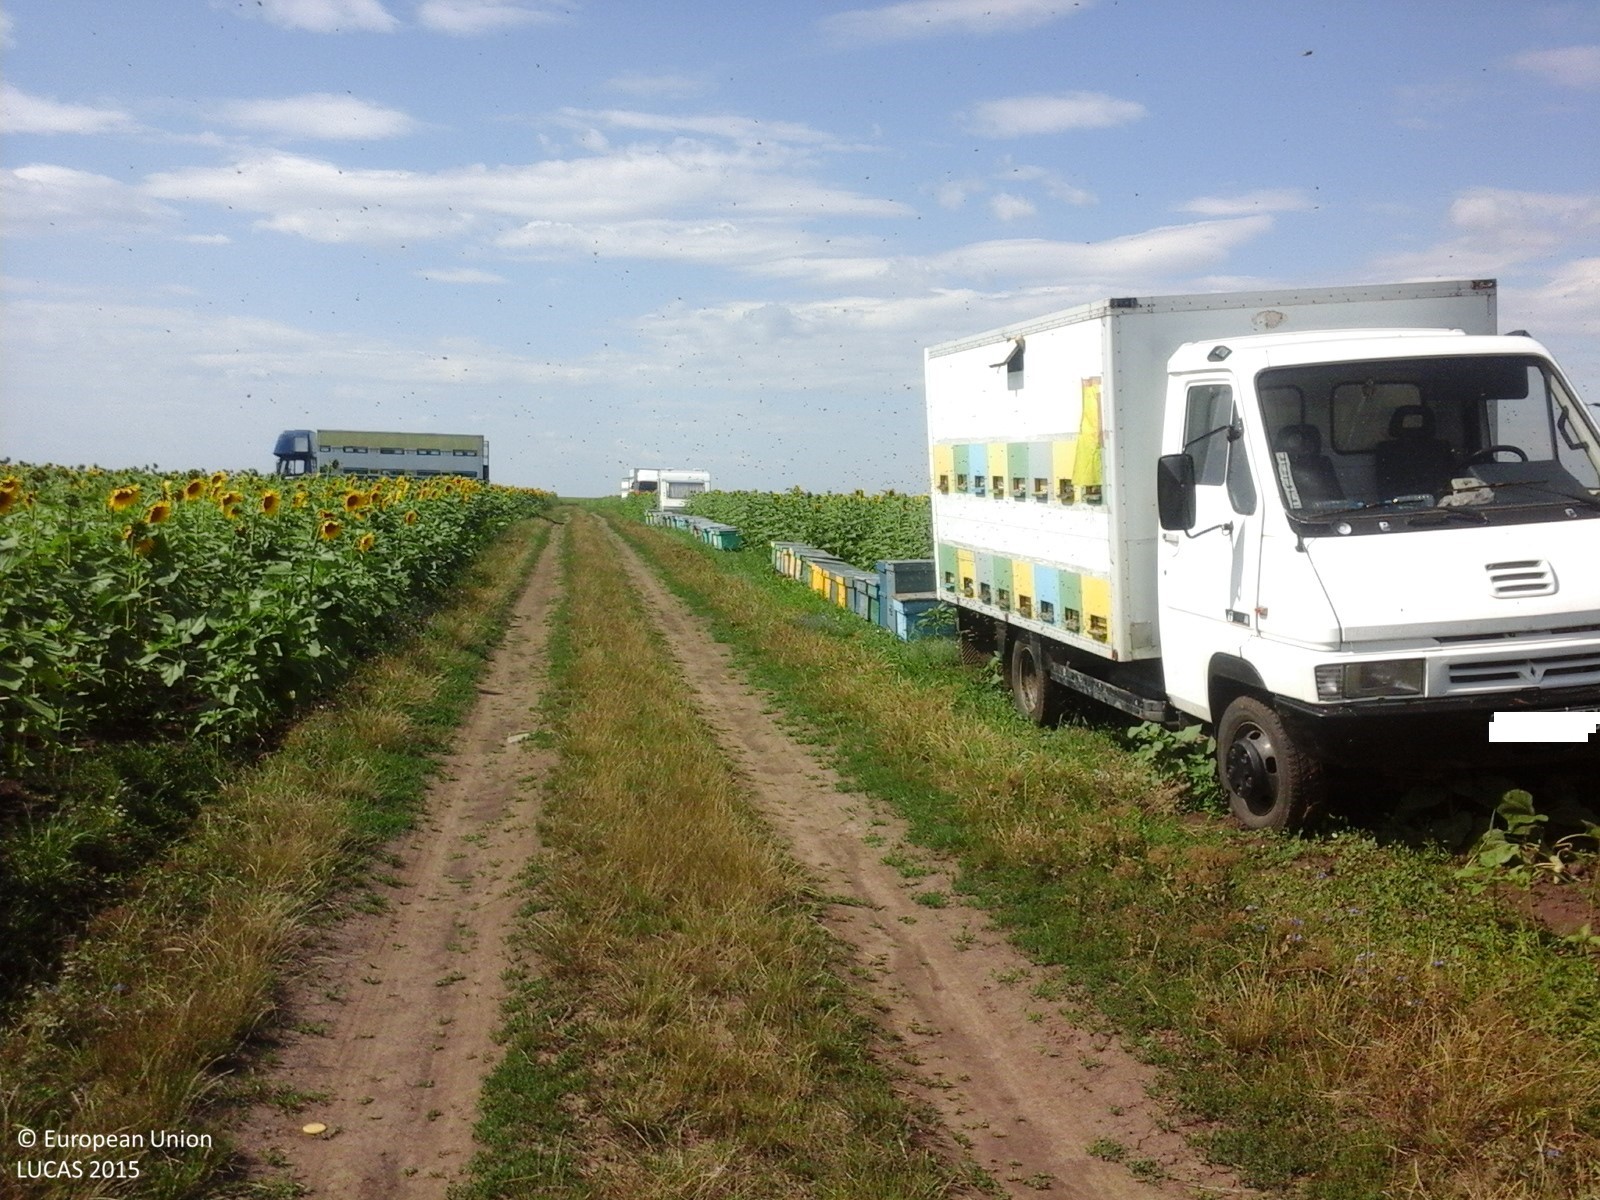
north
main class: Cropland
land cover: Sunflower
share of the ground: > 75 %
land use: Agriculture (excluding fallow land and kitchen gardens)
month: July
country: RO
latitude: 44.0531
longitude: 24.7889
